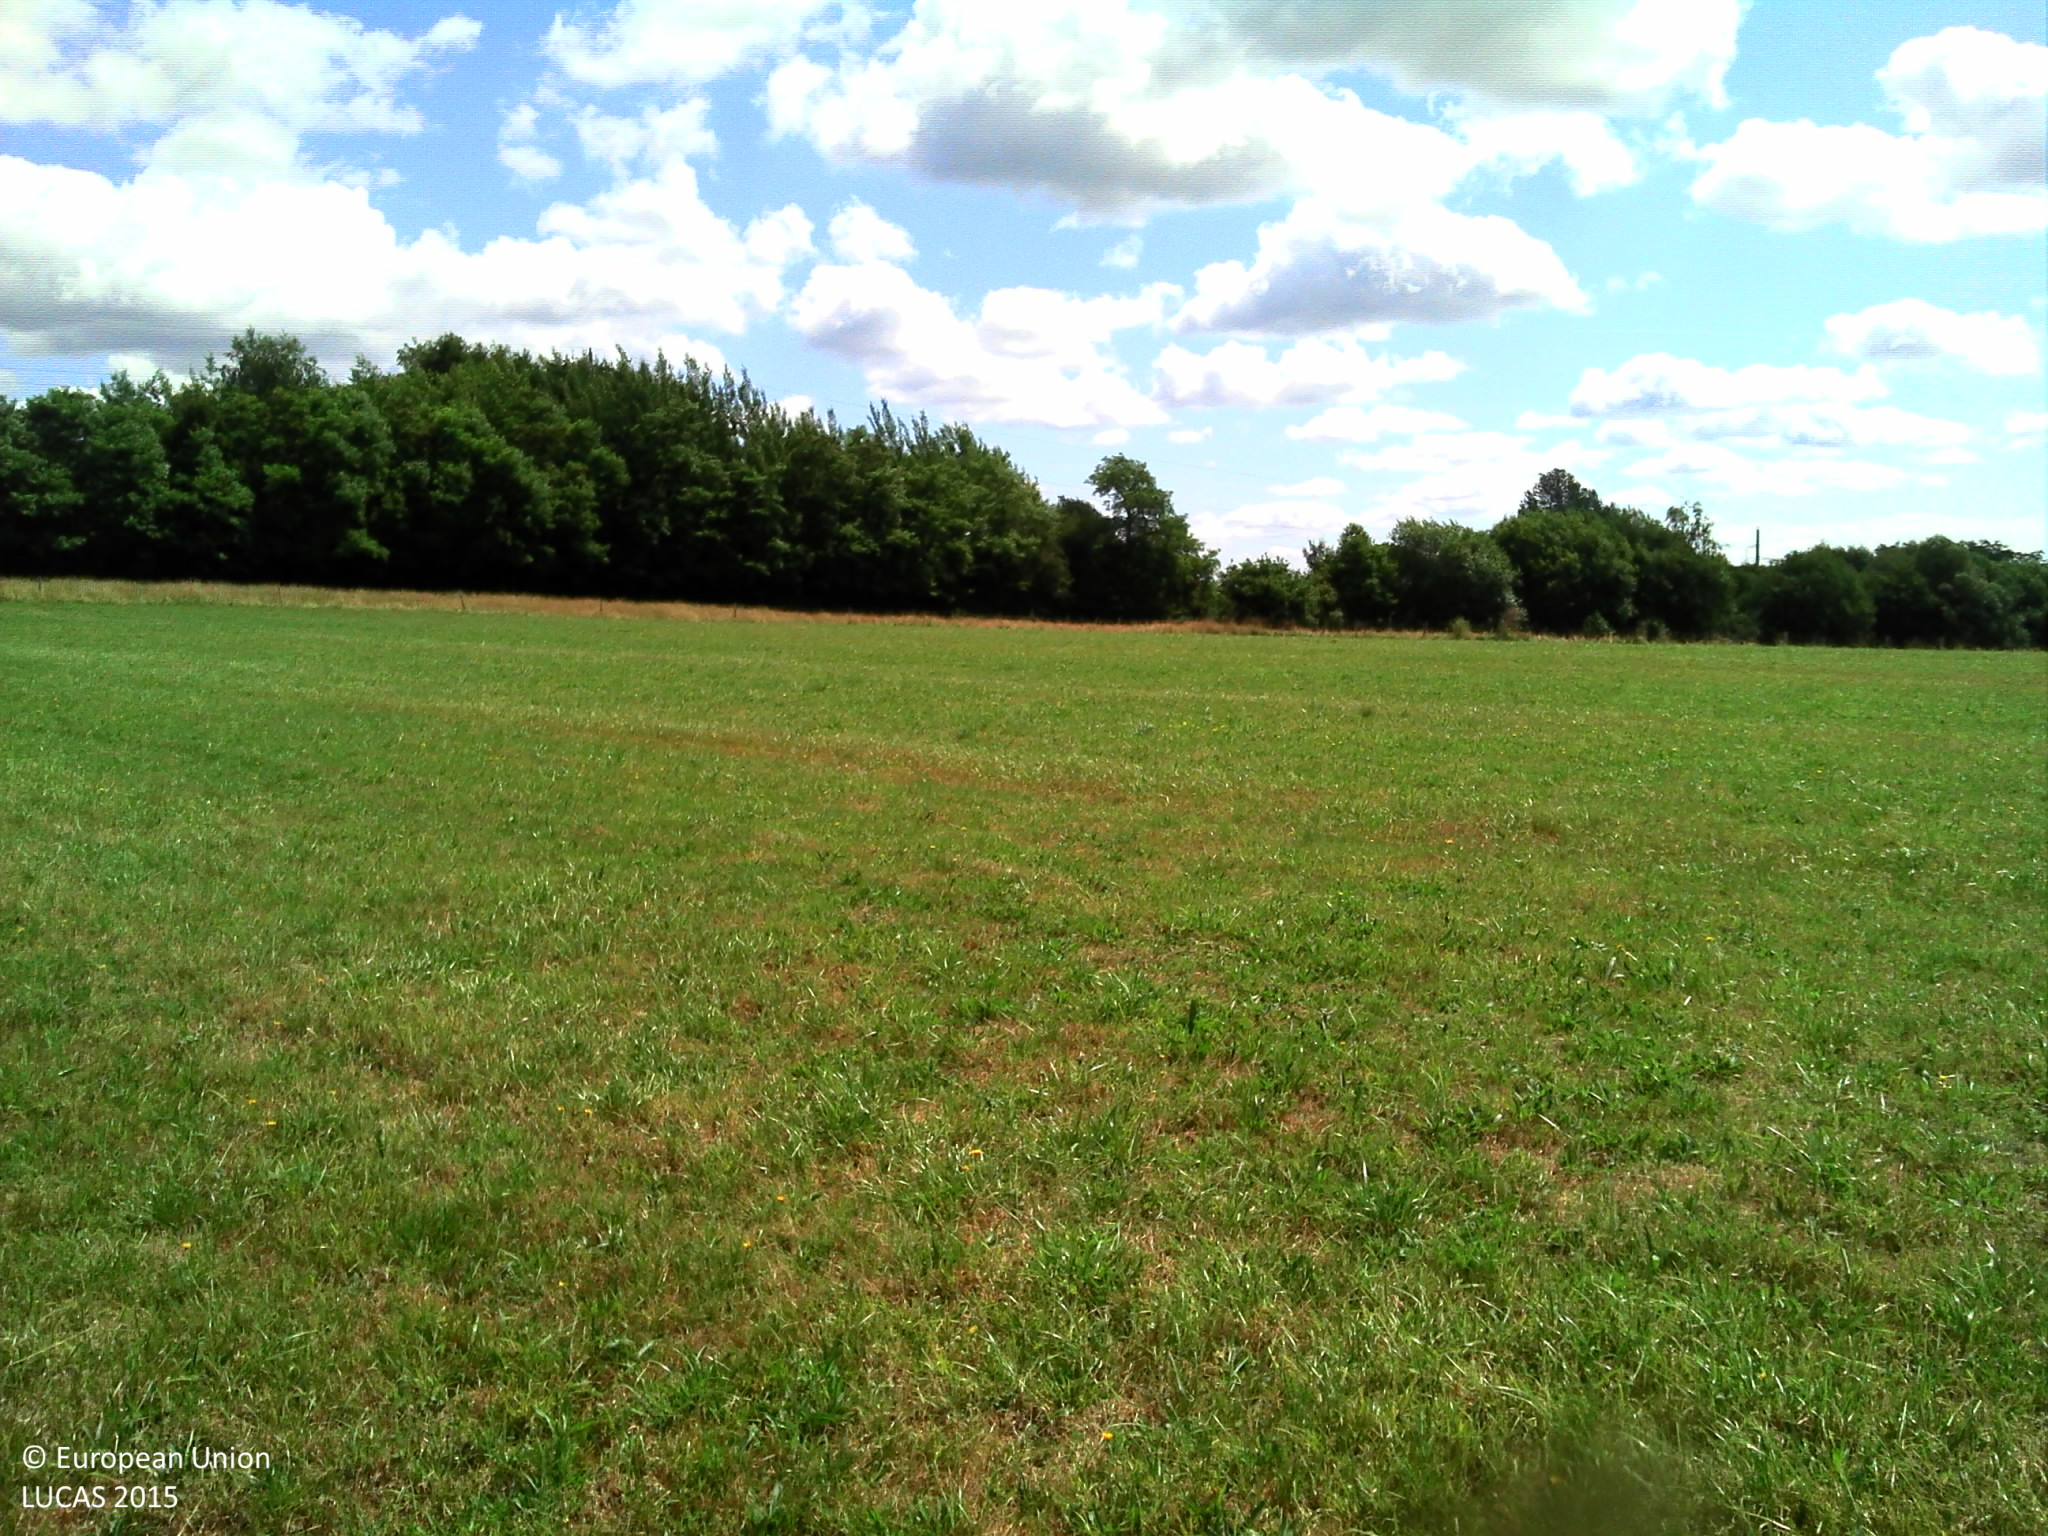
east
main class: Grassland
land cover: Grassland without tree/shrub cover
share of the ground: > 75 %
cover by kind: herbaceous plants 100 %
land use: Agriculture (excluding fallow land and kitchen gardens)
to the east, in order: Grassland without tree/shrub cover; Fences; Grassland without tree/shrub cover; Fences; Grassland without tree/shrub cover; Broadleaved woodland; Ditches and canals; Spontaneously vegetated surfaces; Railways; Grass margins; Ditches and canals; Broadleaved woodland; Grassland without tree/shrub cover; Electric lines; Grassland without tree/shrub cover; Single bushes/trees; Grassland without tree/shrub cover
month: July
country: BE
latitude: 49.7191
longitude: 5.5462
